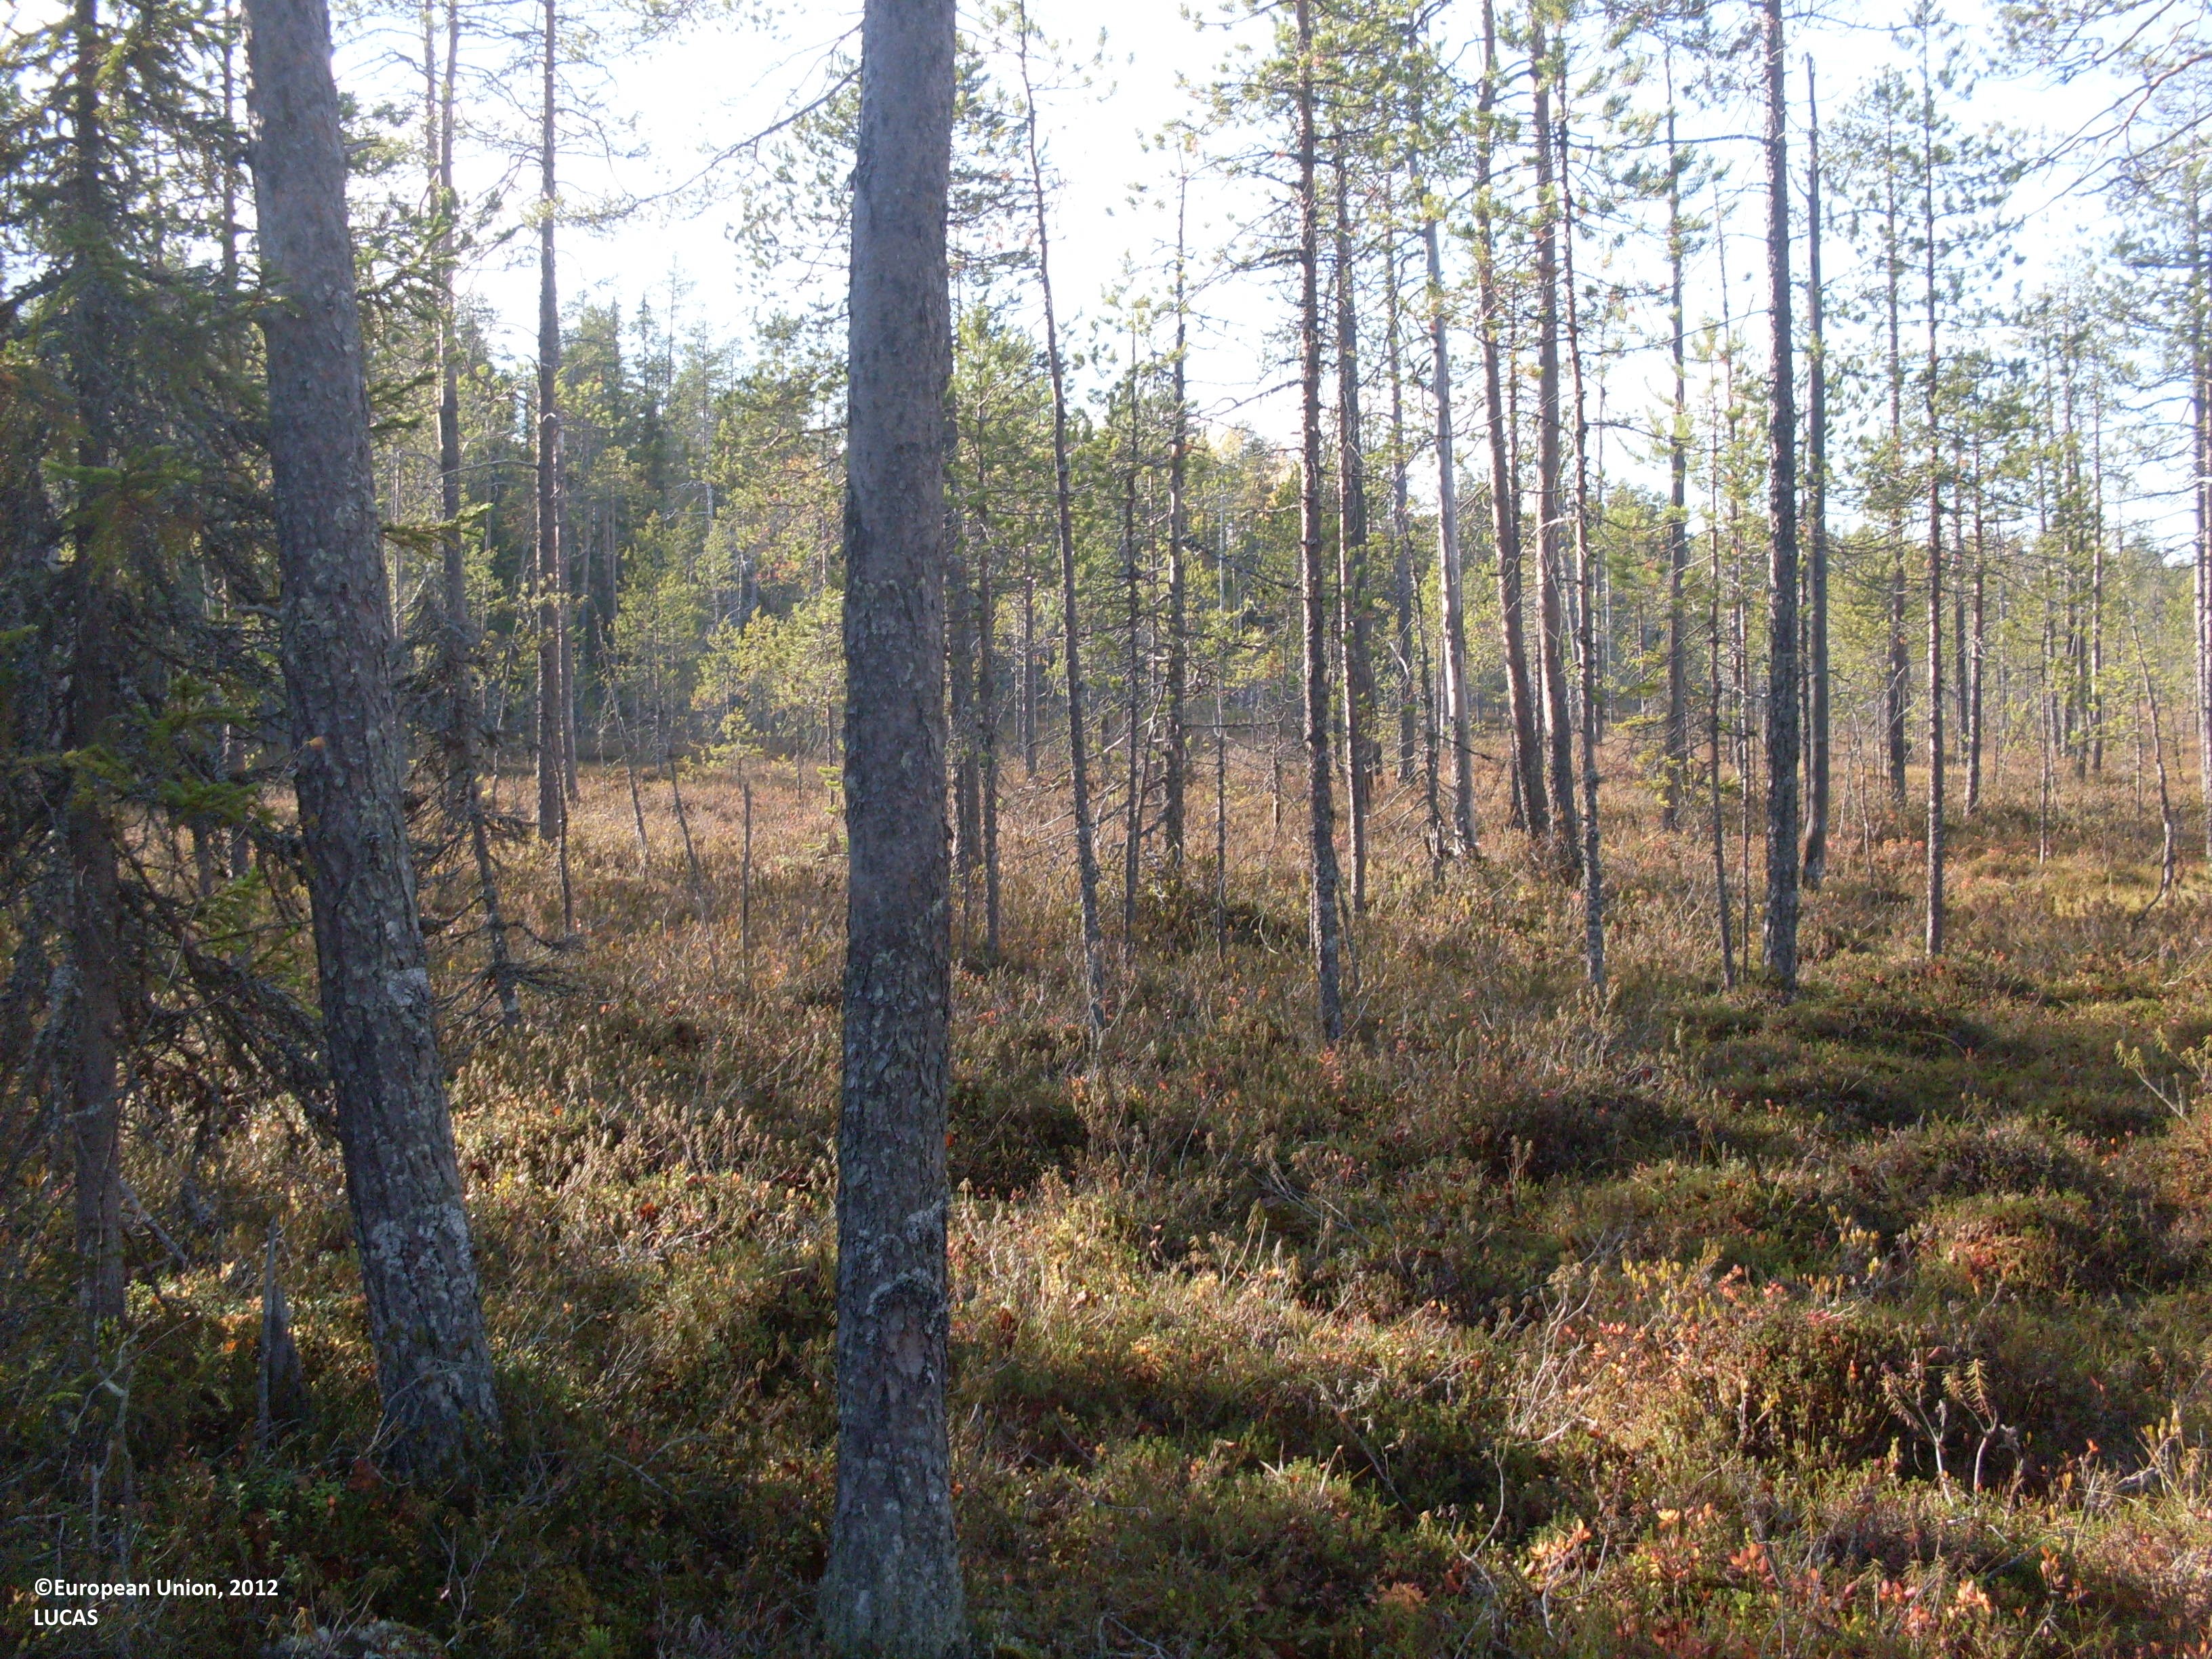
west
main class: Woodland
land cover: Pine dominated coniferous woodland
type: boreal forest
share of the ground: 25 - 50 %
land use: Forestry
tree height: > 5 m
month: September
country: FI
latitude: 64.7728
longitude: 29.7112
